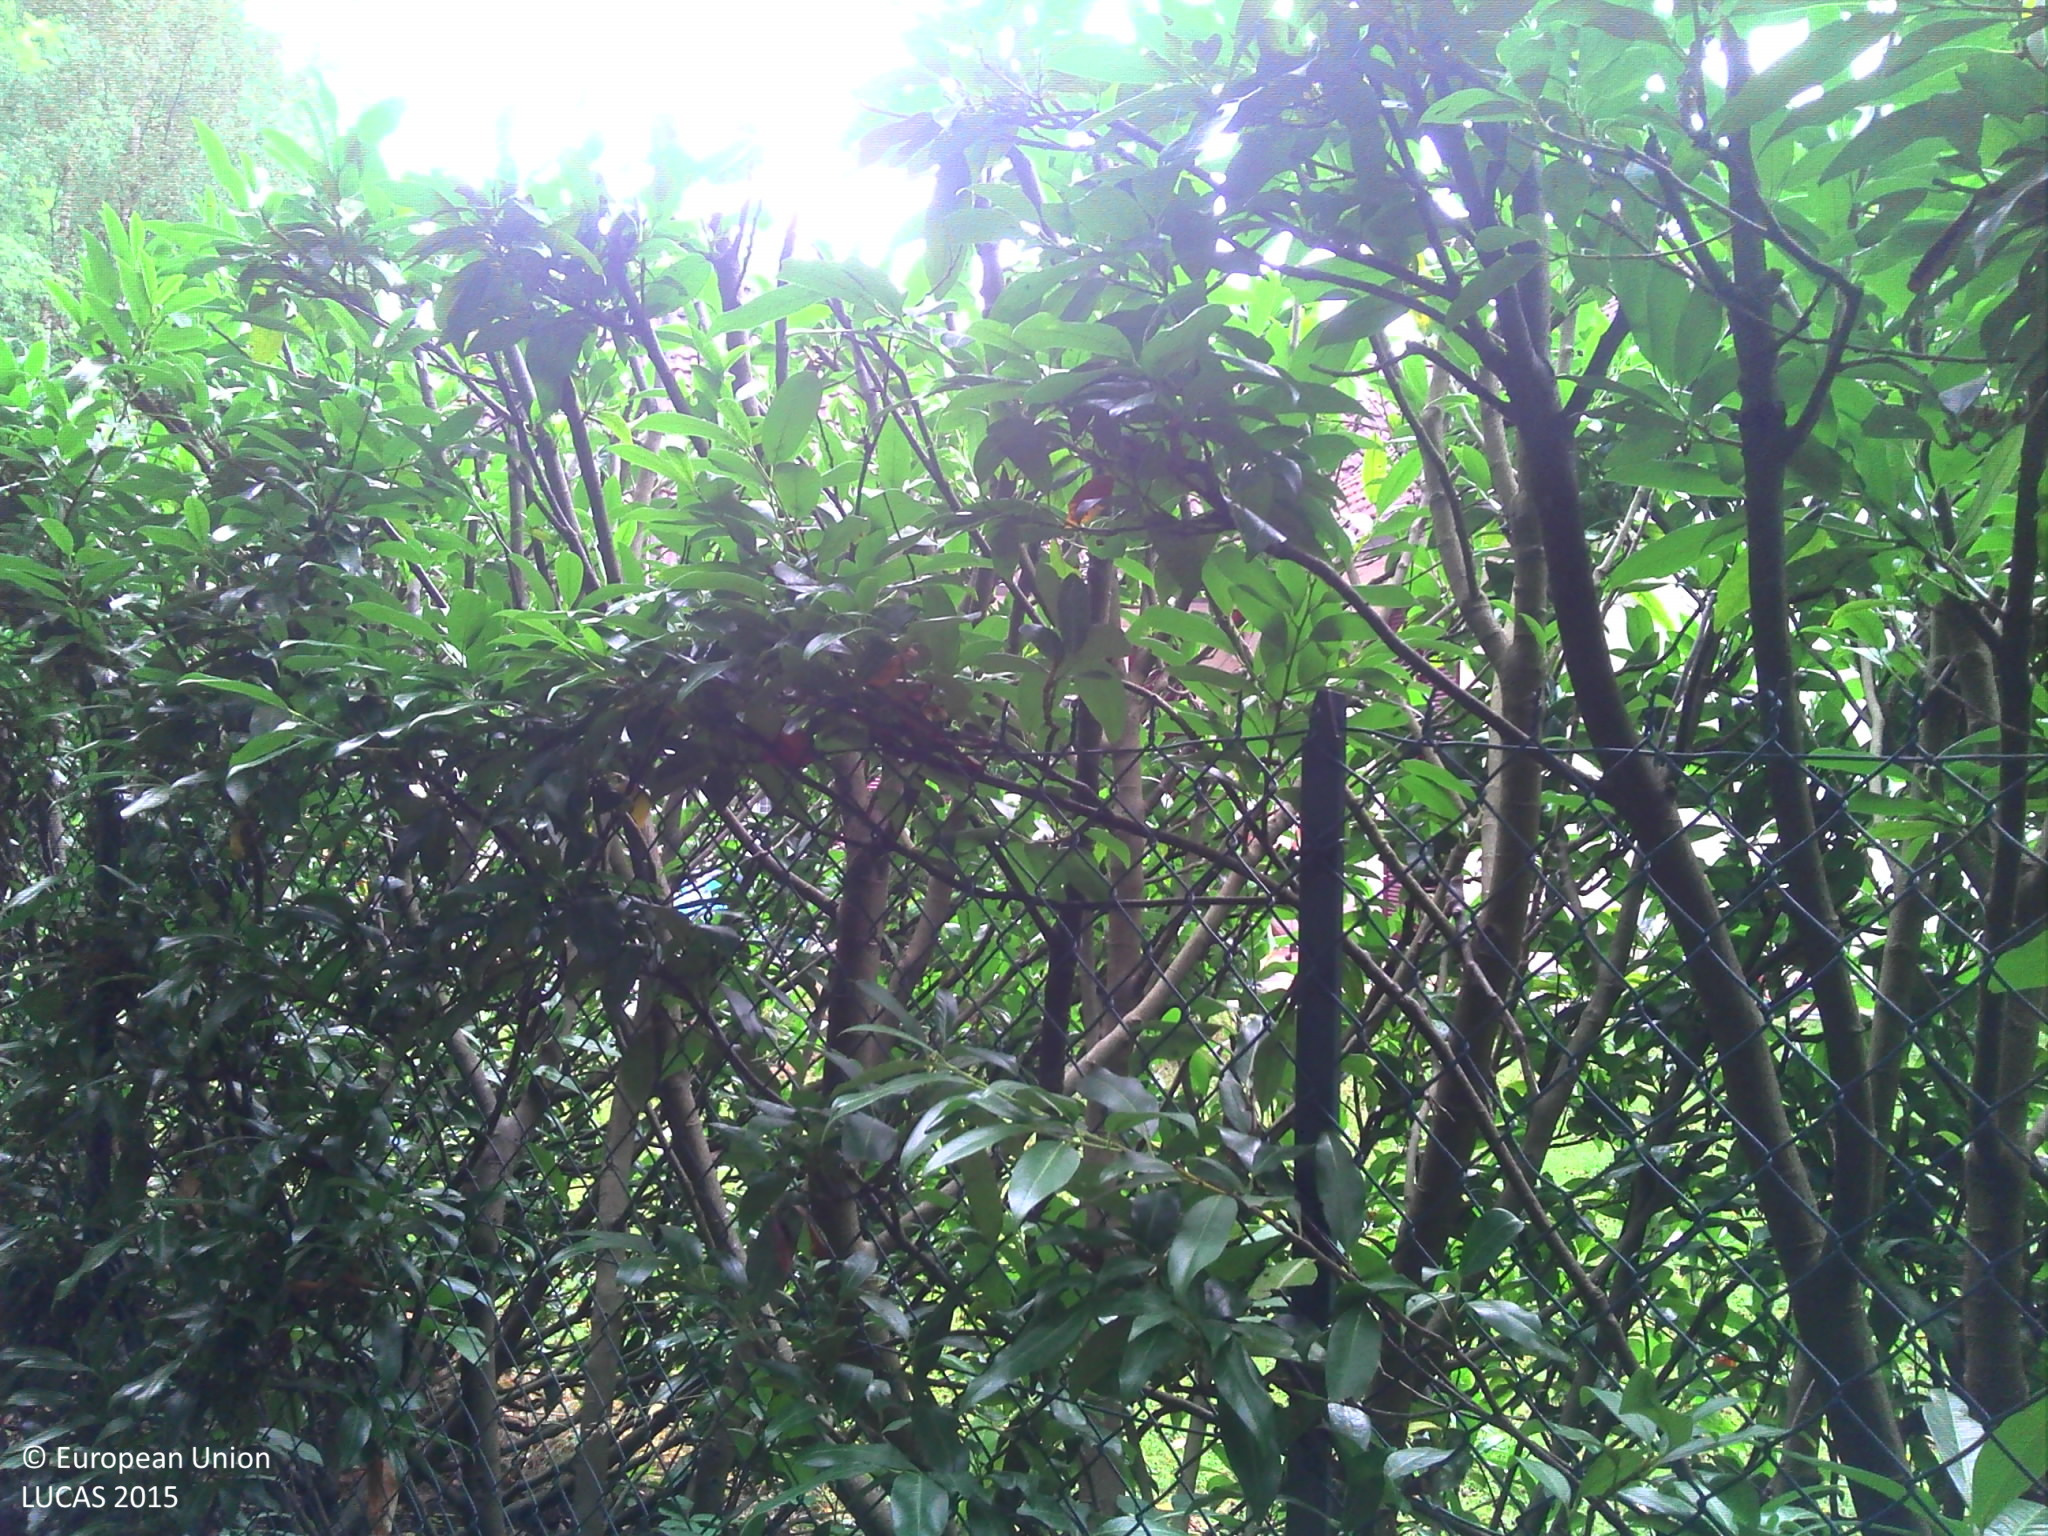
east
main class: Grassland
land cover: Grassland with sparse tree/shrub cover
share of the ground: > 75 %
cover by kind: herbaceous plants 80 %, lichens and mosses 10 %, broadleaved forest trees 5 %, consolidated bare surface 5 %
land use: Residential
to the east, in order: Grassland with sparse tree/shrub cover; Artificial constructions in urban areas; Broadleaved woodland; Artificial constructions in urban areas
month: July
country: FR
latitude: 48.7572
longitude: 2.6852
